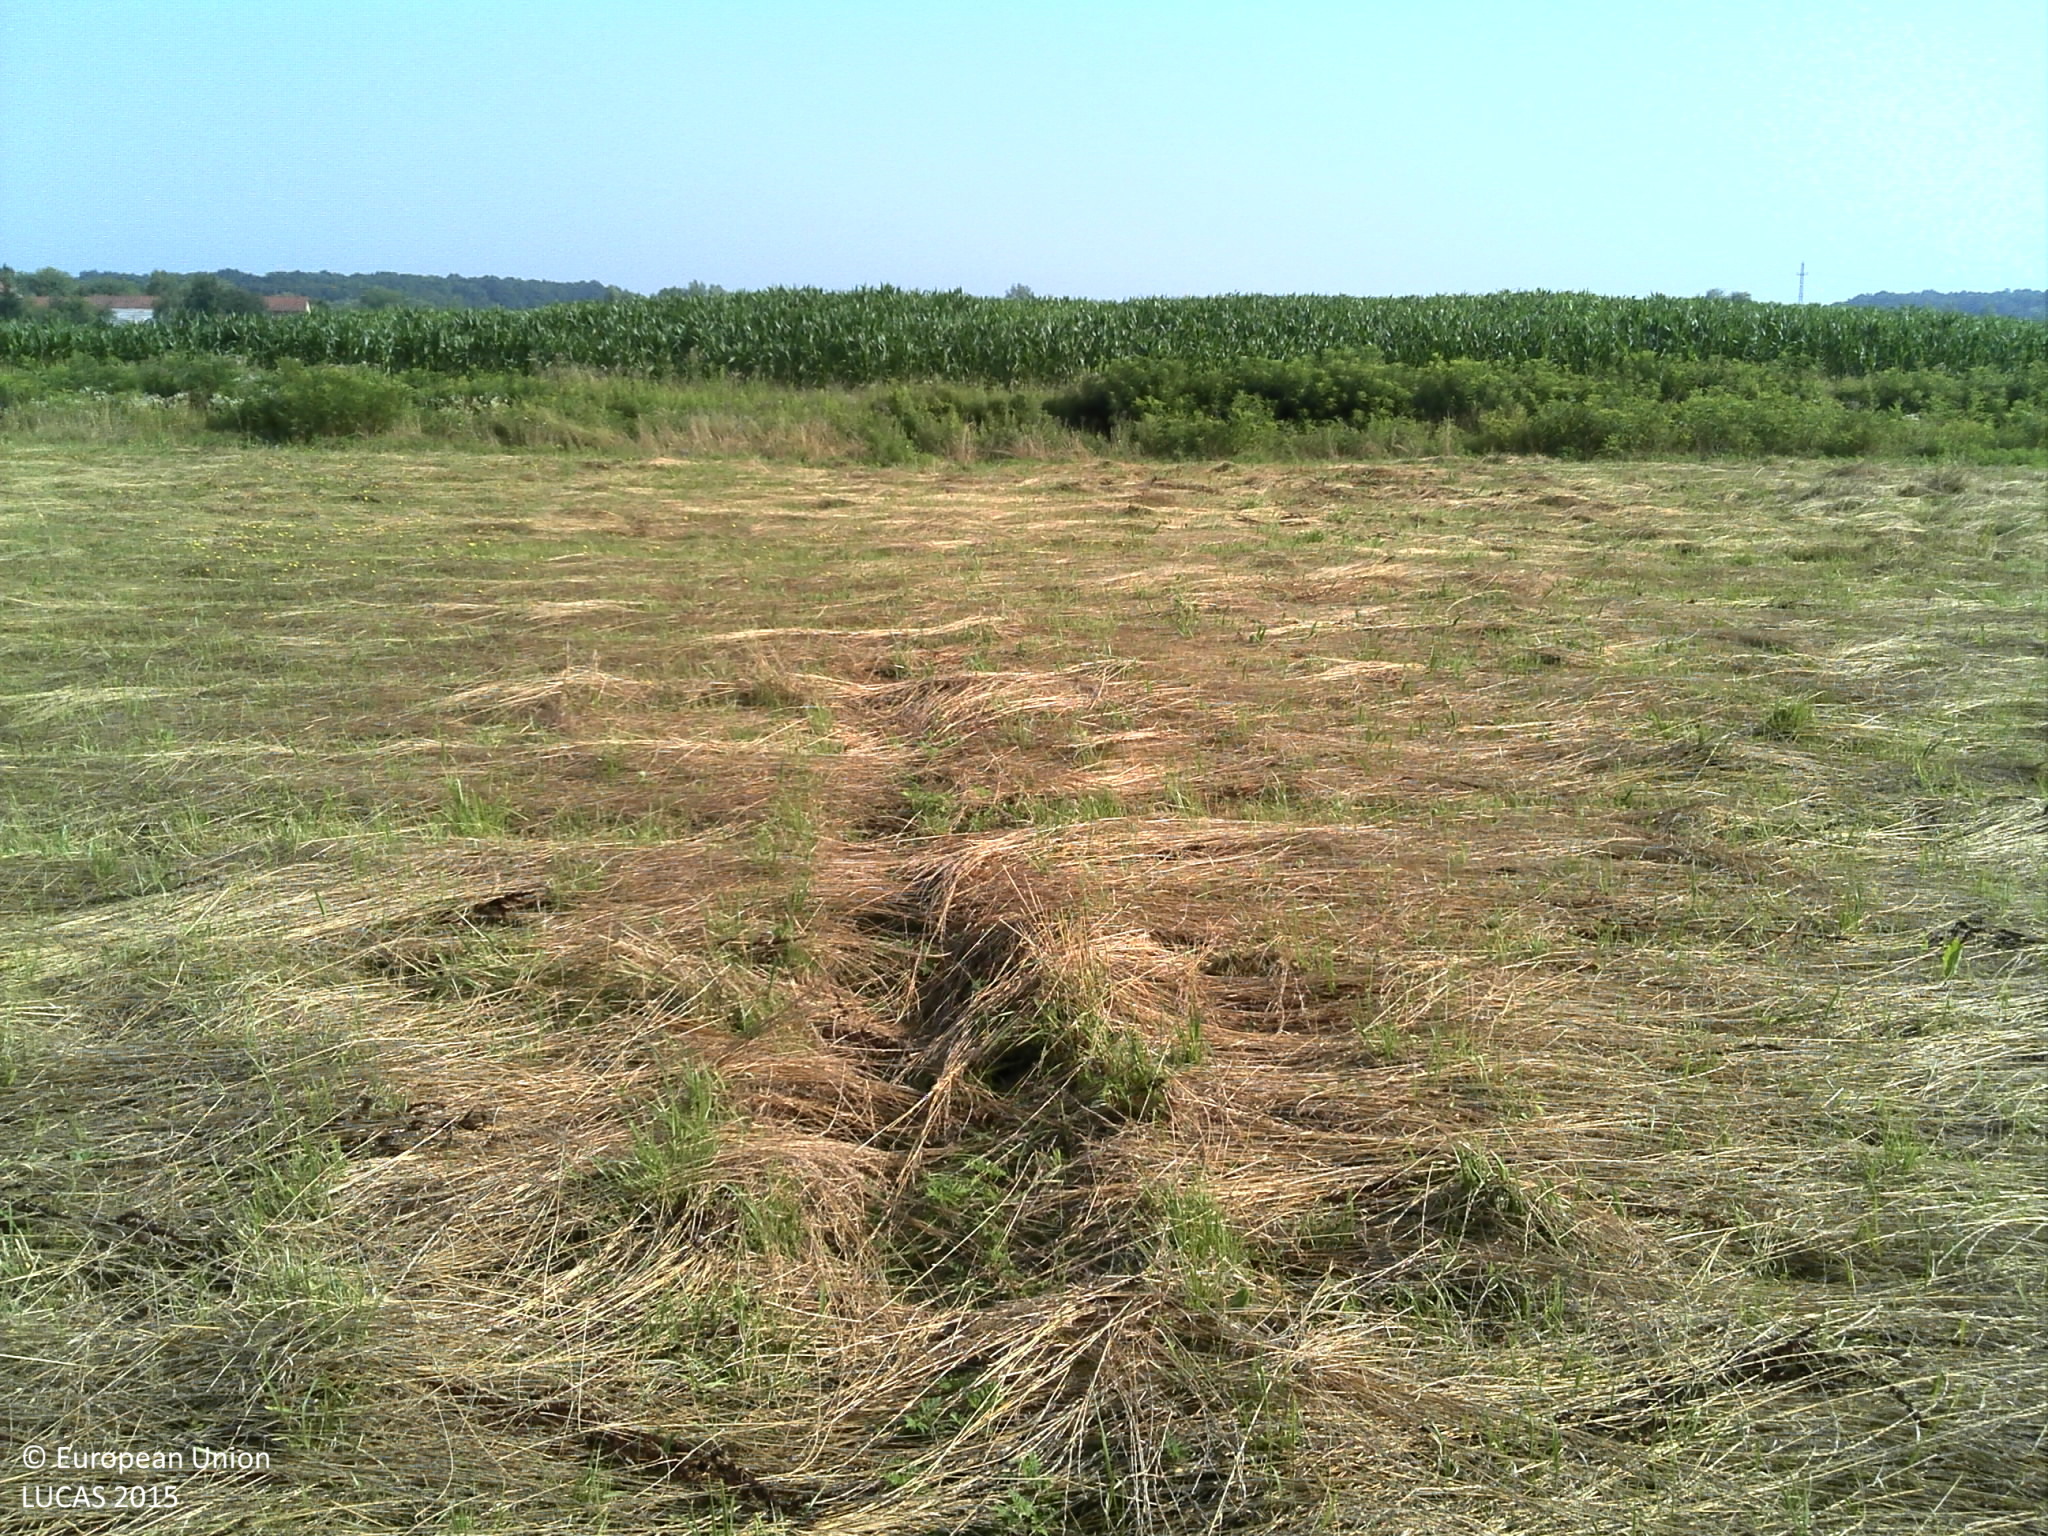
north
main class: Cropland
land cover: Temporary grasslands
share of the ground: > 75 %
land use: Agriculture (excluding fallow land and kitchen gardens)
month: July
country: HR
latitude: 45.7517
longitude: 16.5681
